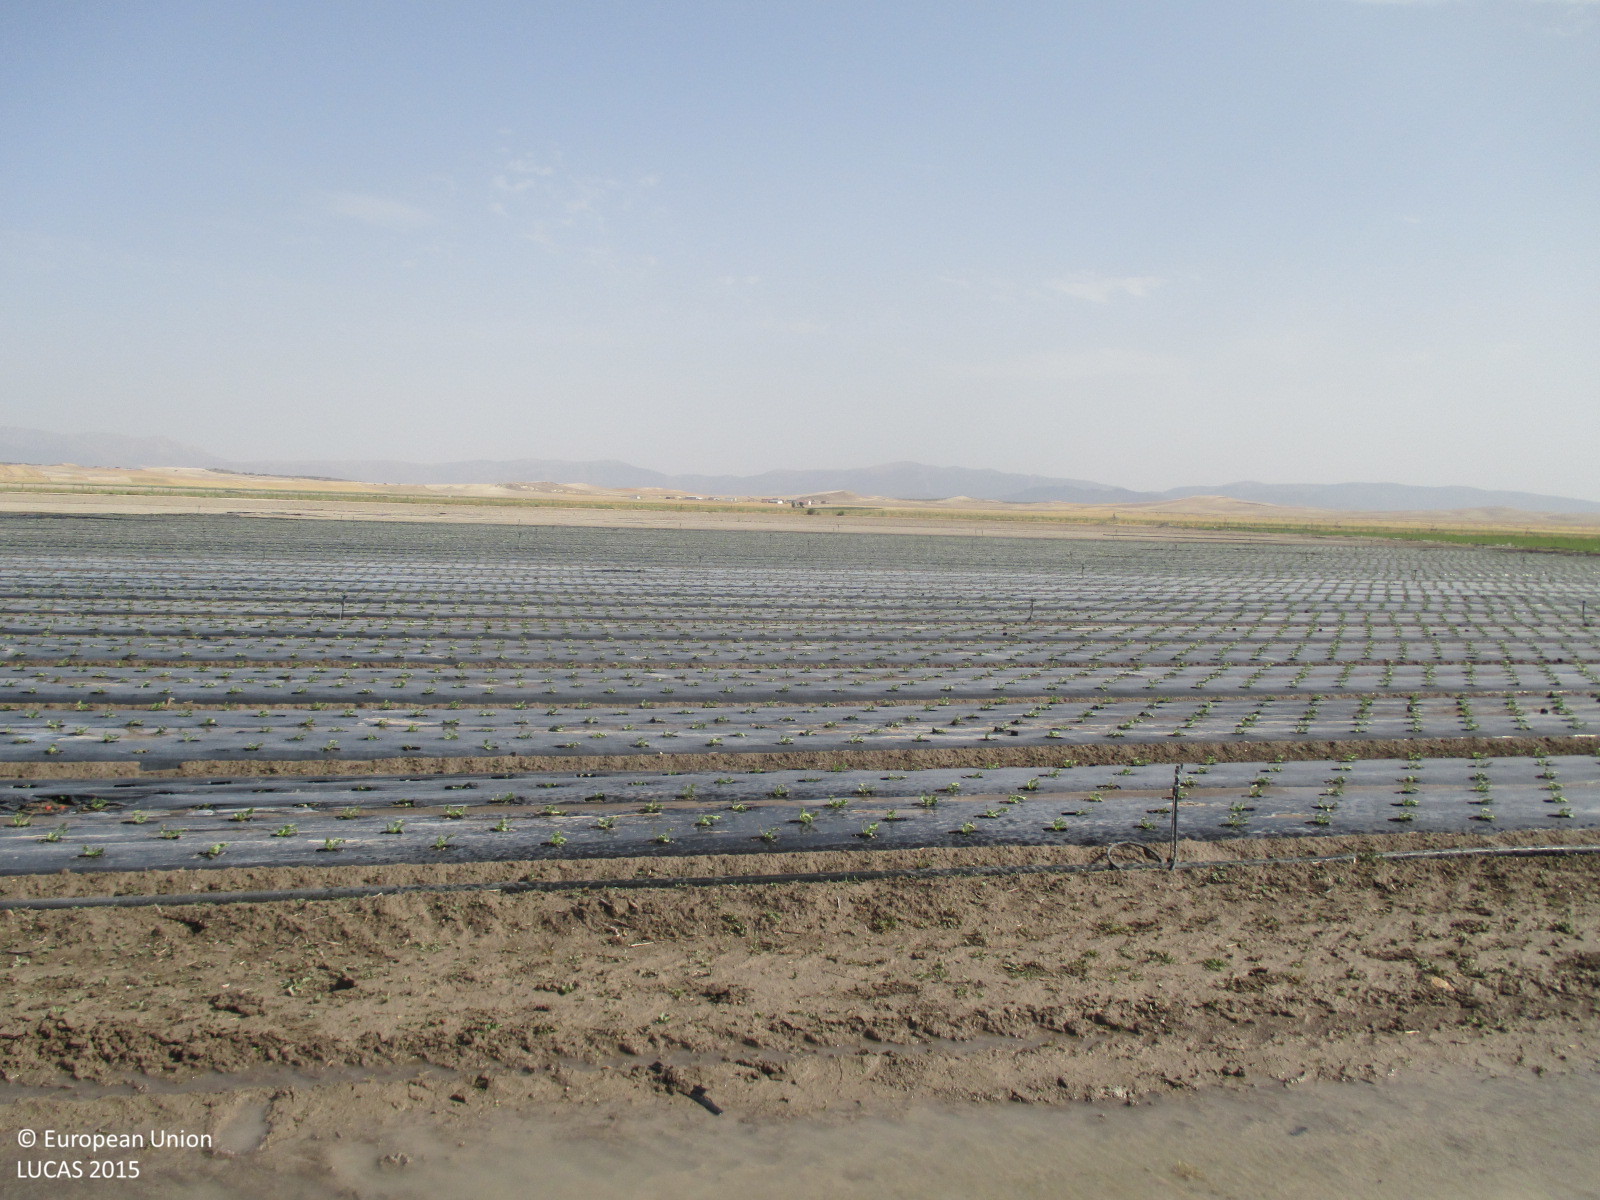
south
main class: Cropland
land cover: Other fresh vegetables
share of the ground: 10 - 25 %
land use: Agriculture (excluding fallow land and kitchen gardens)
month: July
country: ES
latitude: 37.8265
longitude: -2.4298
